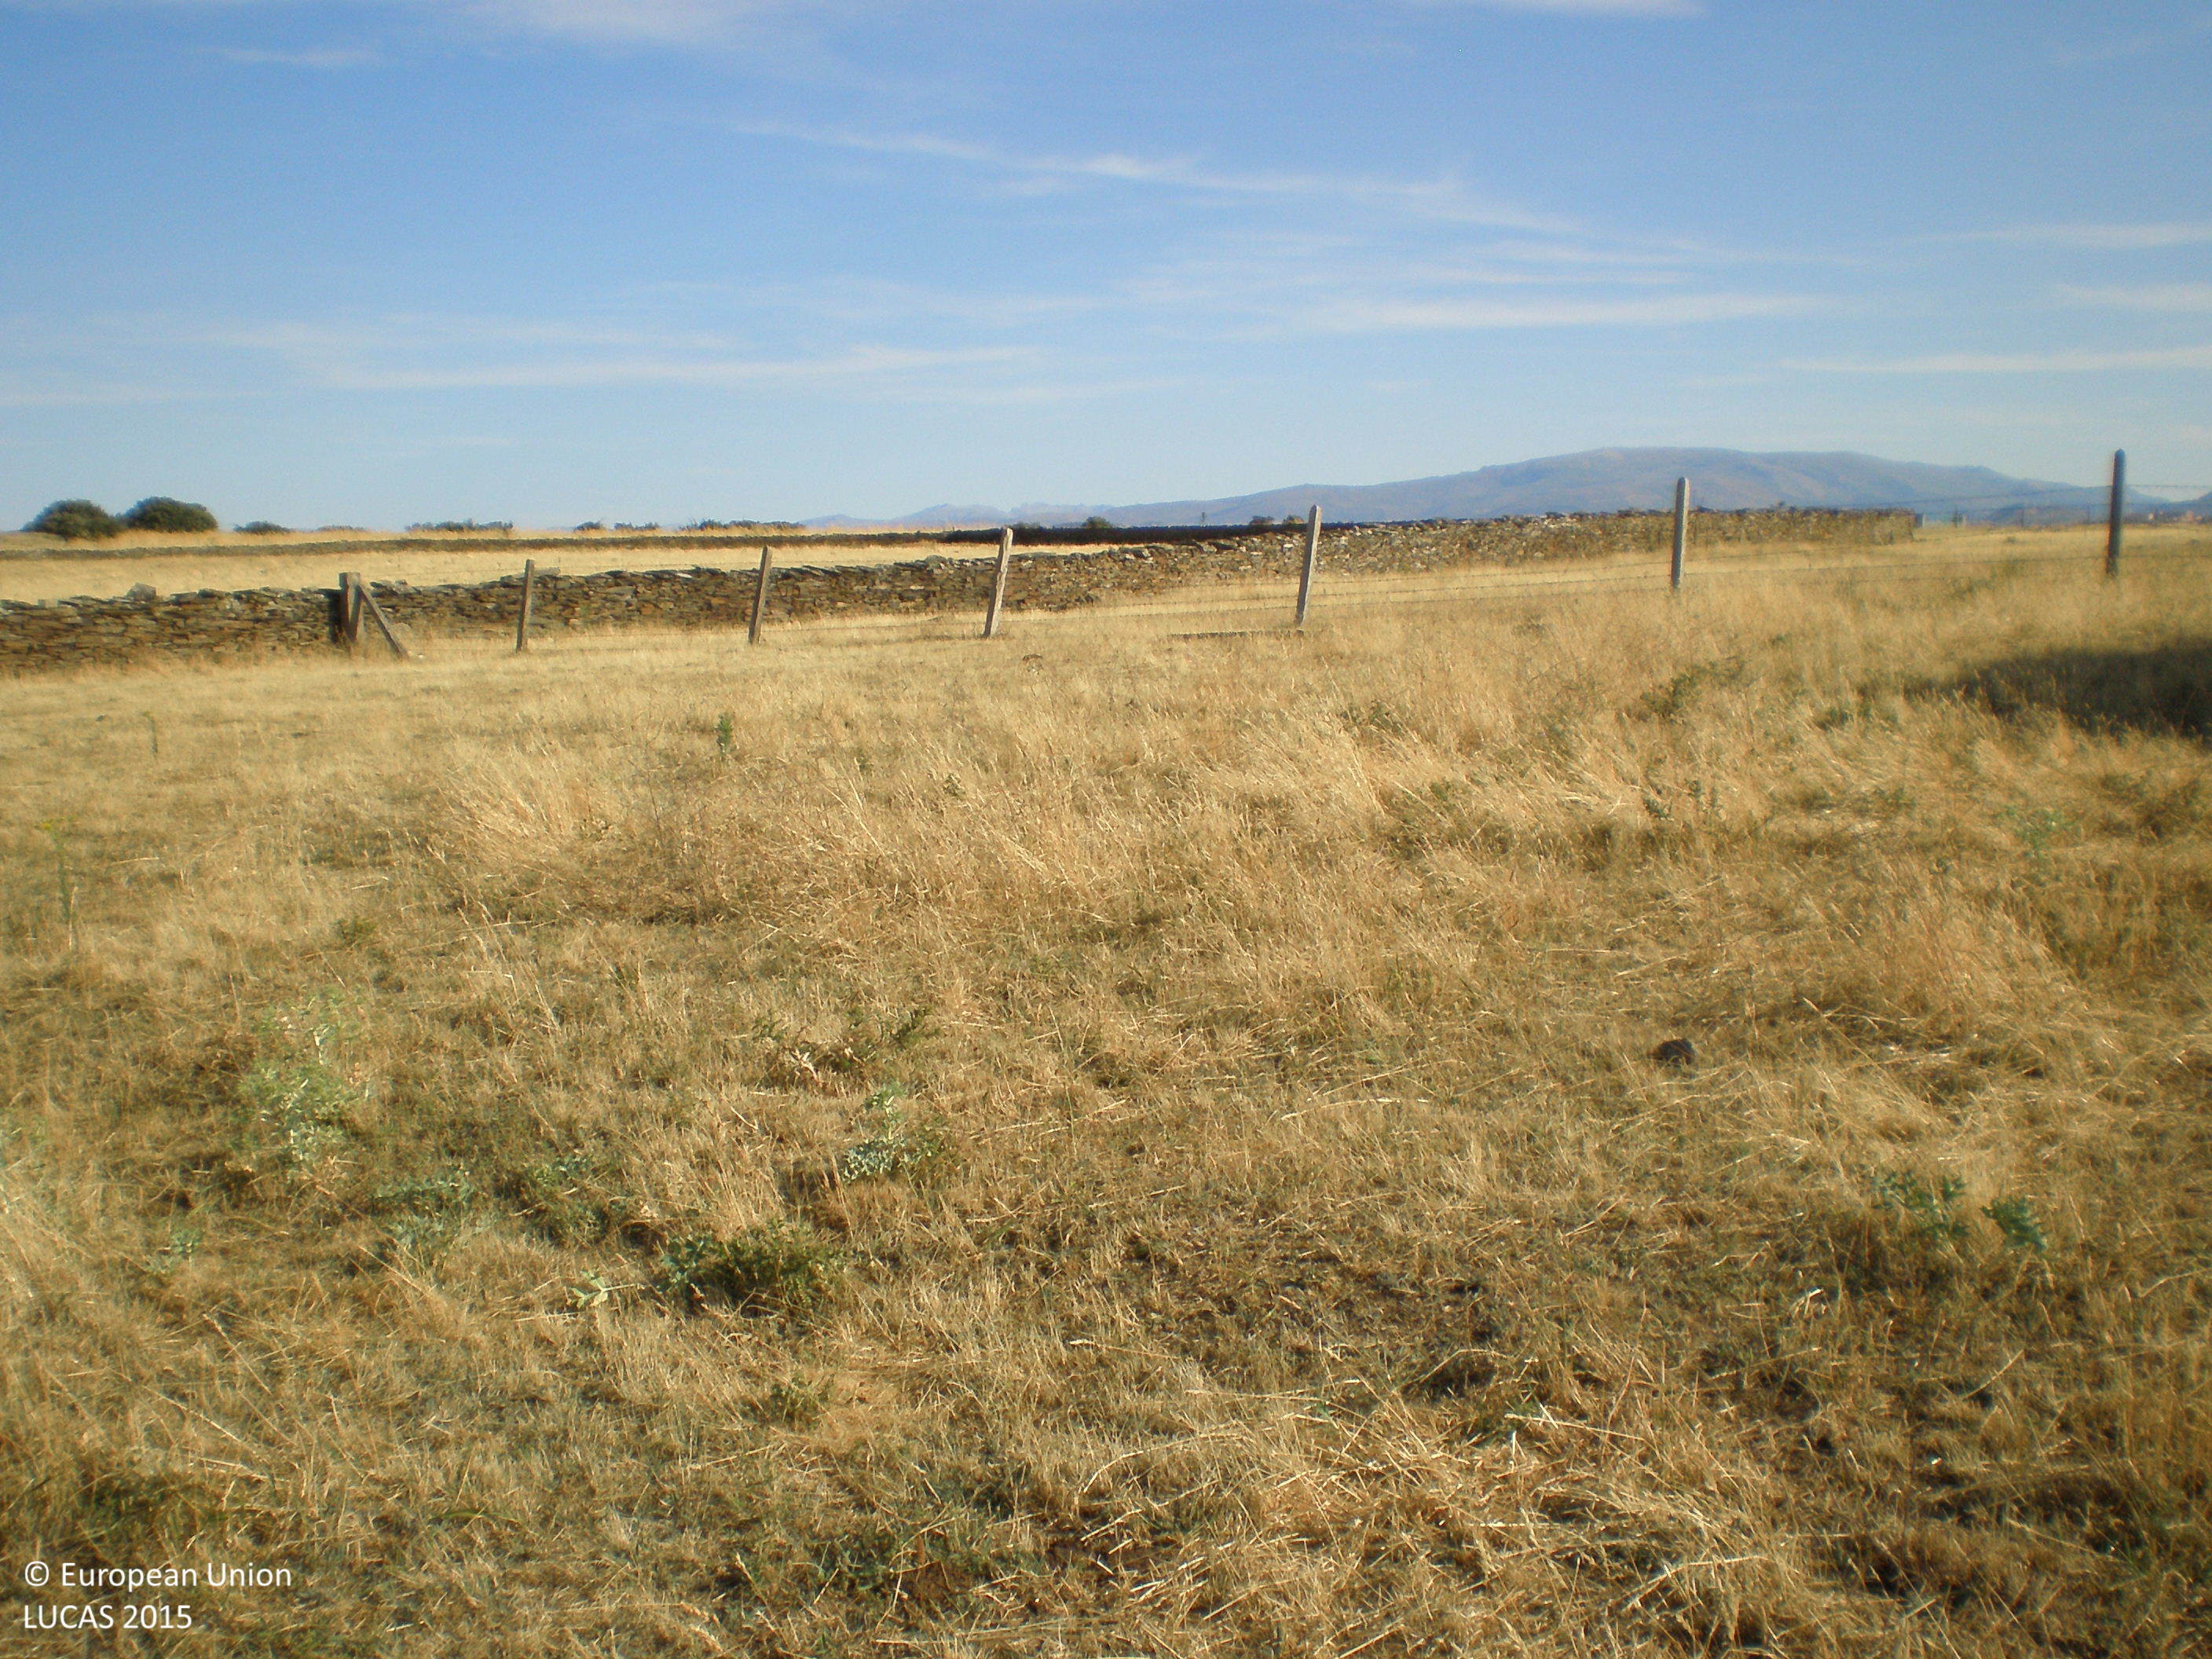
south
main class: Grassland
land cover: Grassland without tree/shrub cover
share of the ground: > 75 %
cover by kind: herbaceous plants 100 %
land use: Agriculture (excluding fallow land and kitchen gardens)
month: July
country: ES
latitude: 40.5830
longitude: -5.6546
